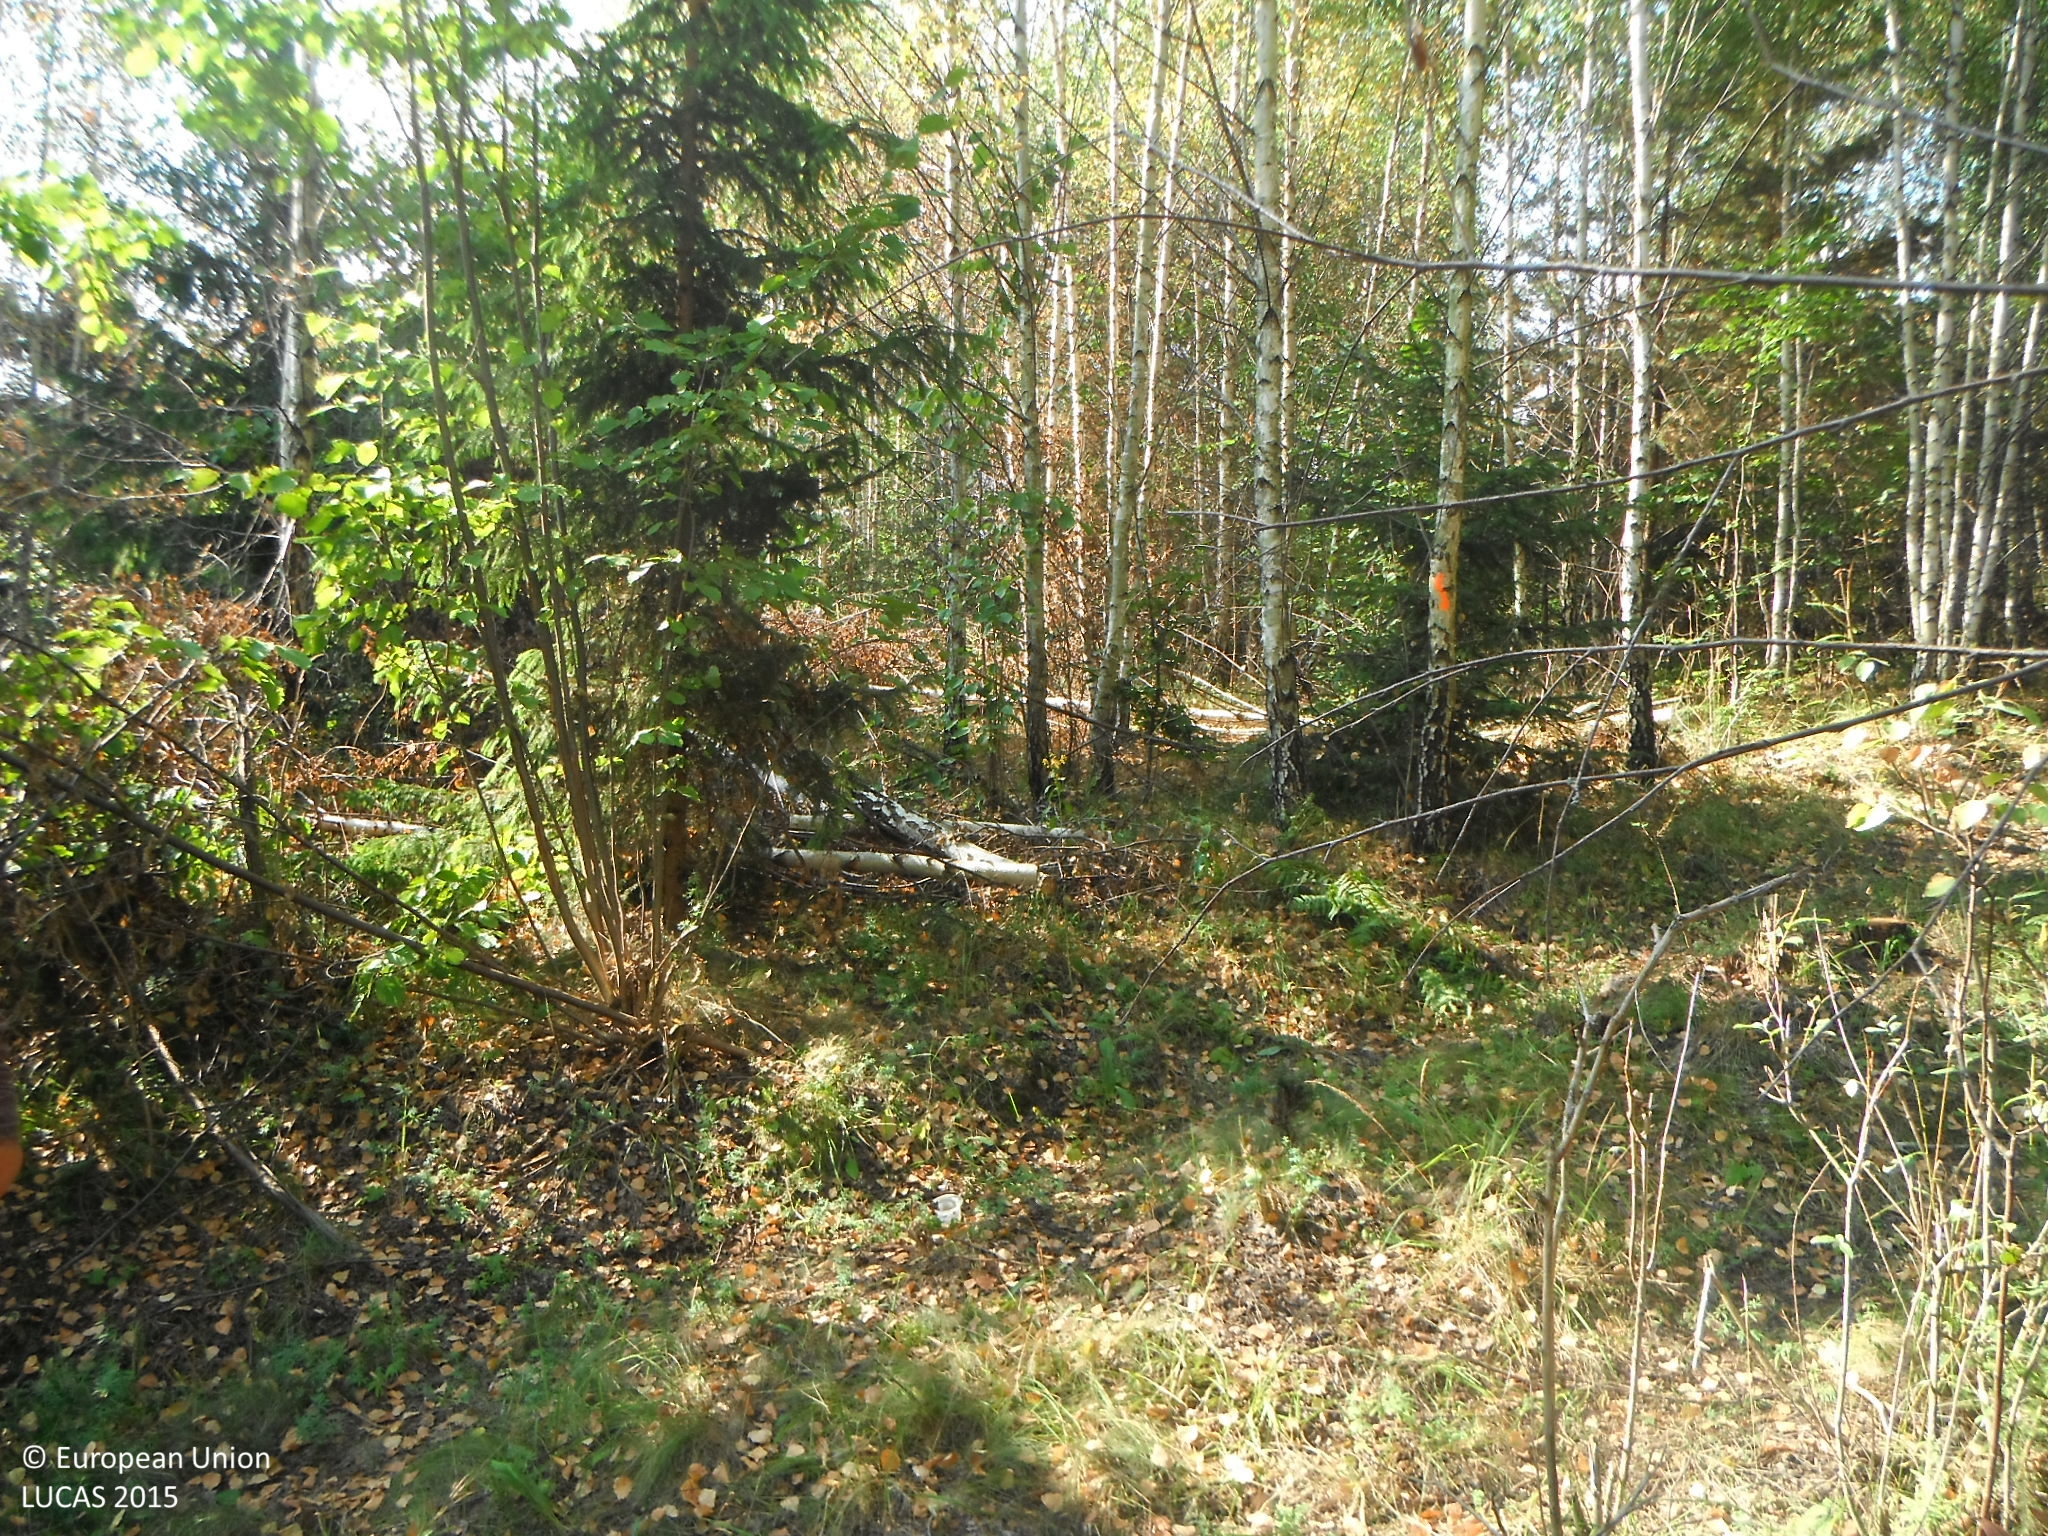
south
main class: Woodland
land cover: Spruce dominated mixed woodland
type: hemiboreal forest and nemoral coniferous forest and mixed broadleaved-coniferous forest
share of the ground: > 75 %
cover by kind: coniferous forest trees 60 %, broadleaved forest trees 40 %
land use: Forestry
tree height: > 5 m
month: September
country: SK
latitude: 48.9686
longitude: 20.3478
